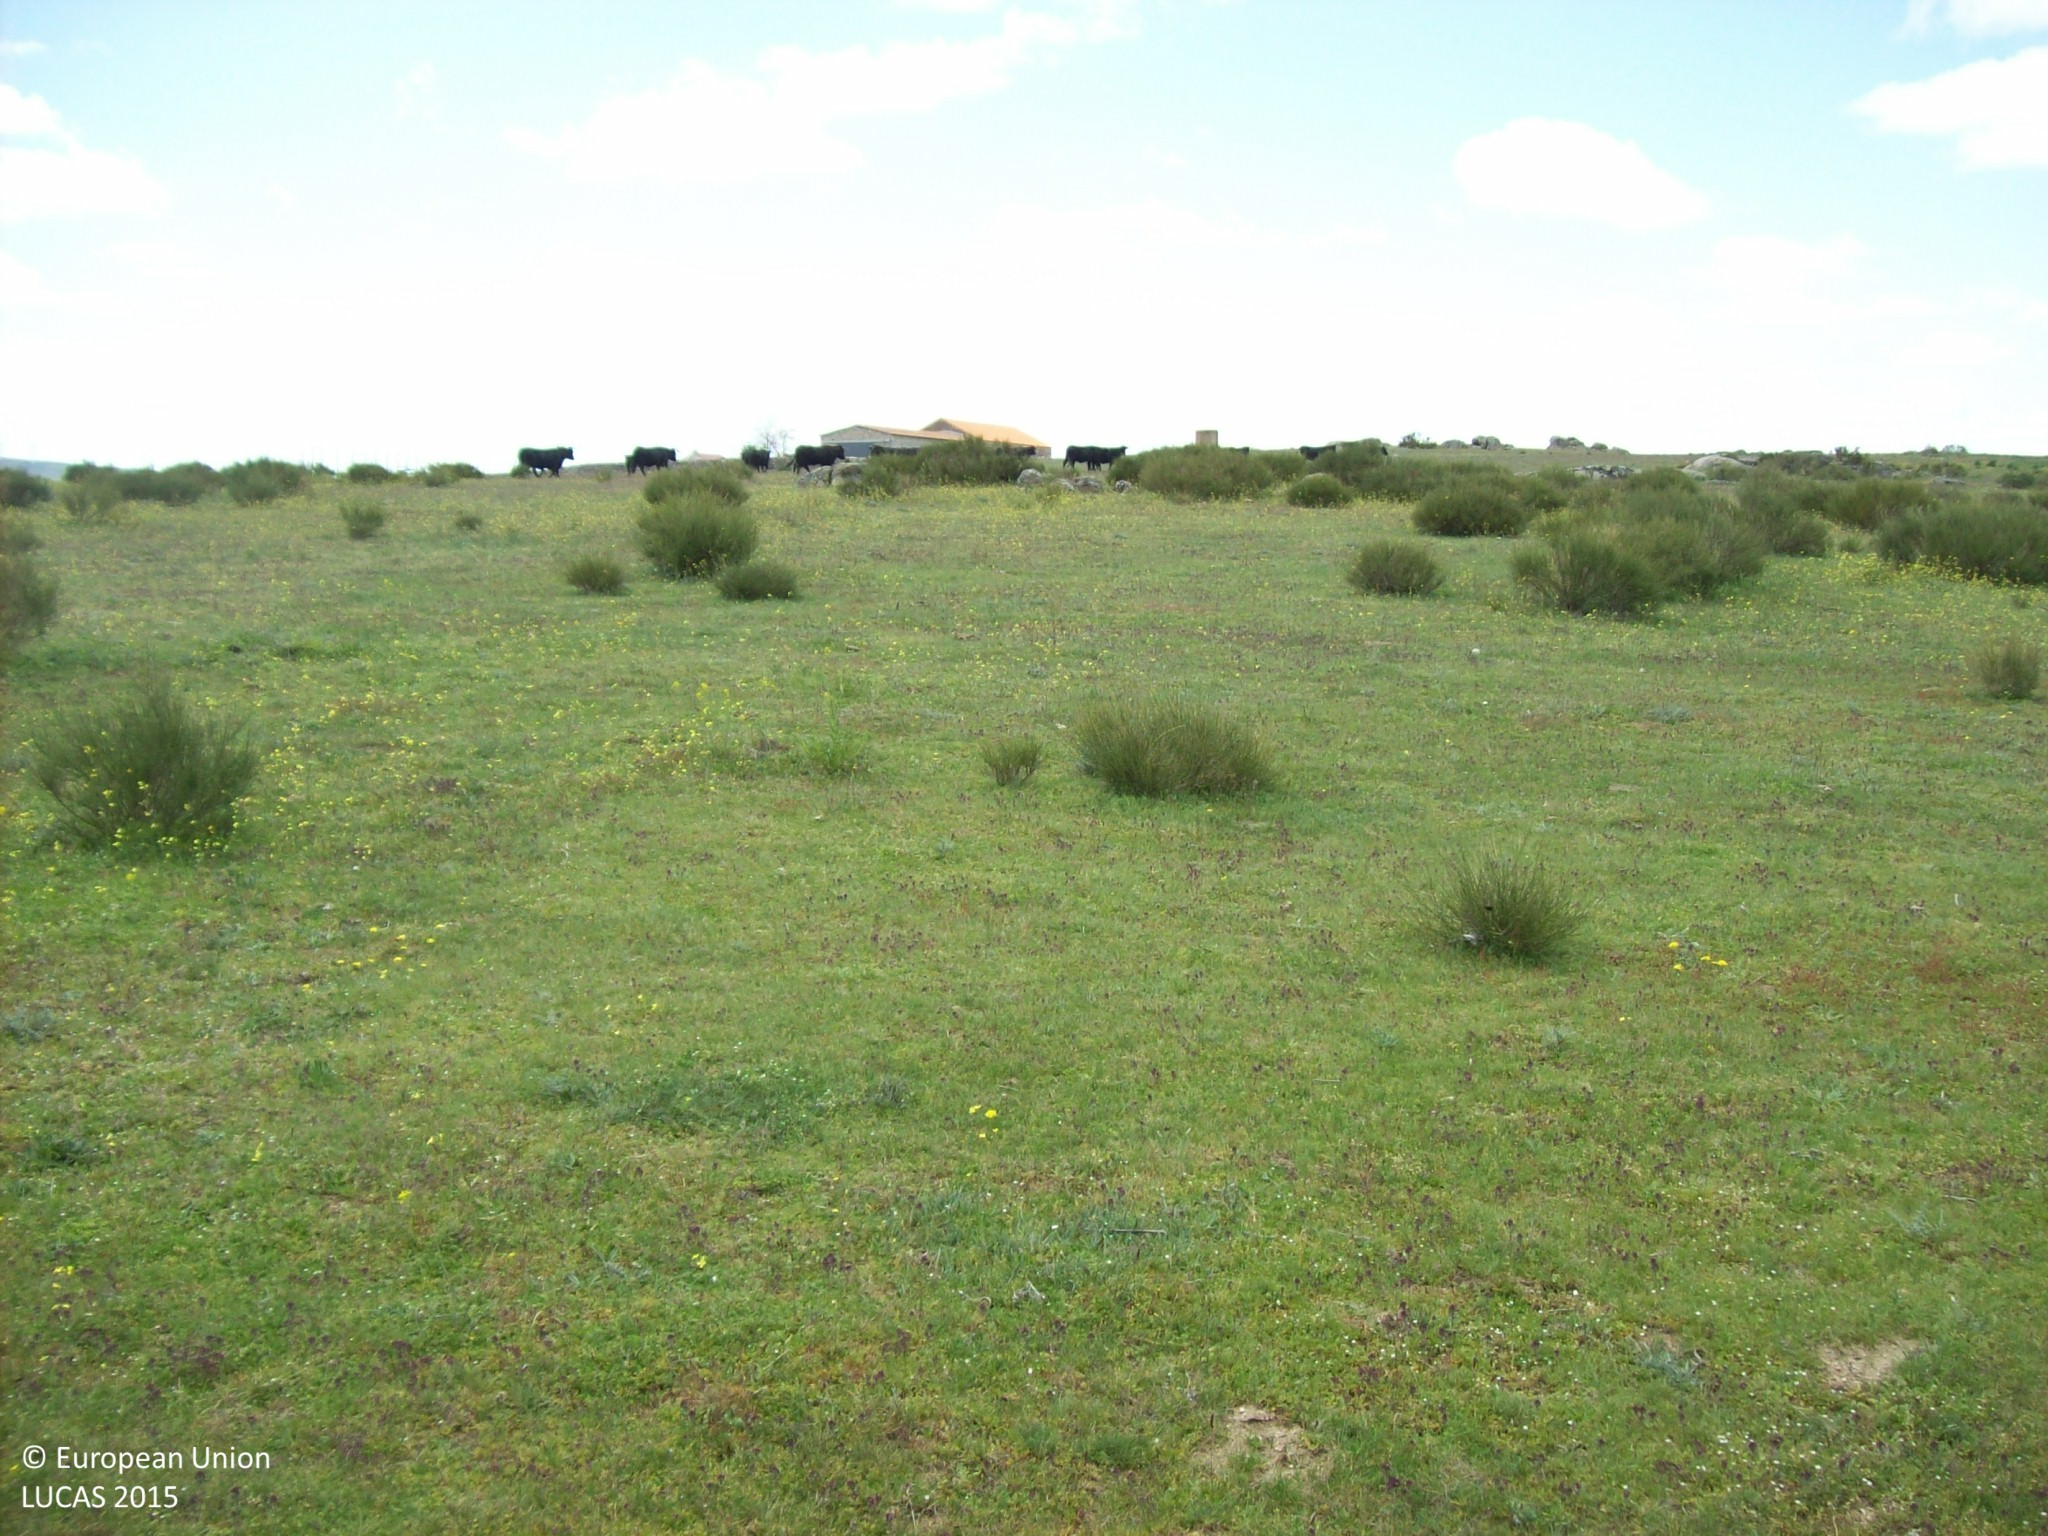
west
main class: Grassland
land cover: Grassland without tree/shrub cover
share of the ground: > 75 %
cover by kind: herbaceous plants 95 %, shrubs 5 %
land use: Agriculture (excluding fallow land and kitchen gardens)
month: May
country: ES
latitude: 40.6593
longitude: -4.4459
